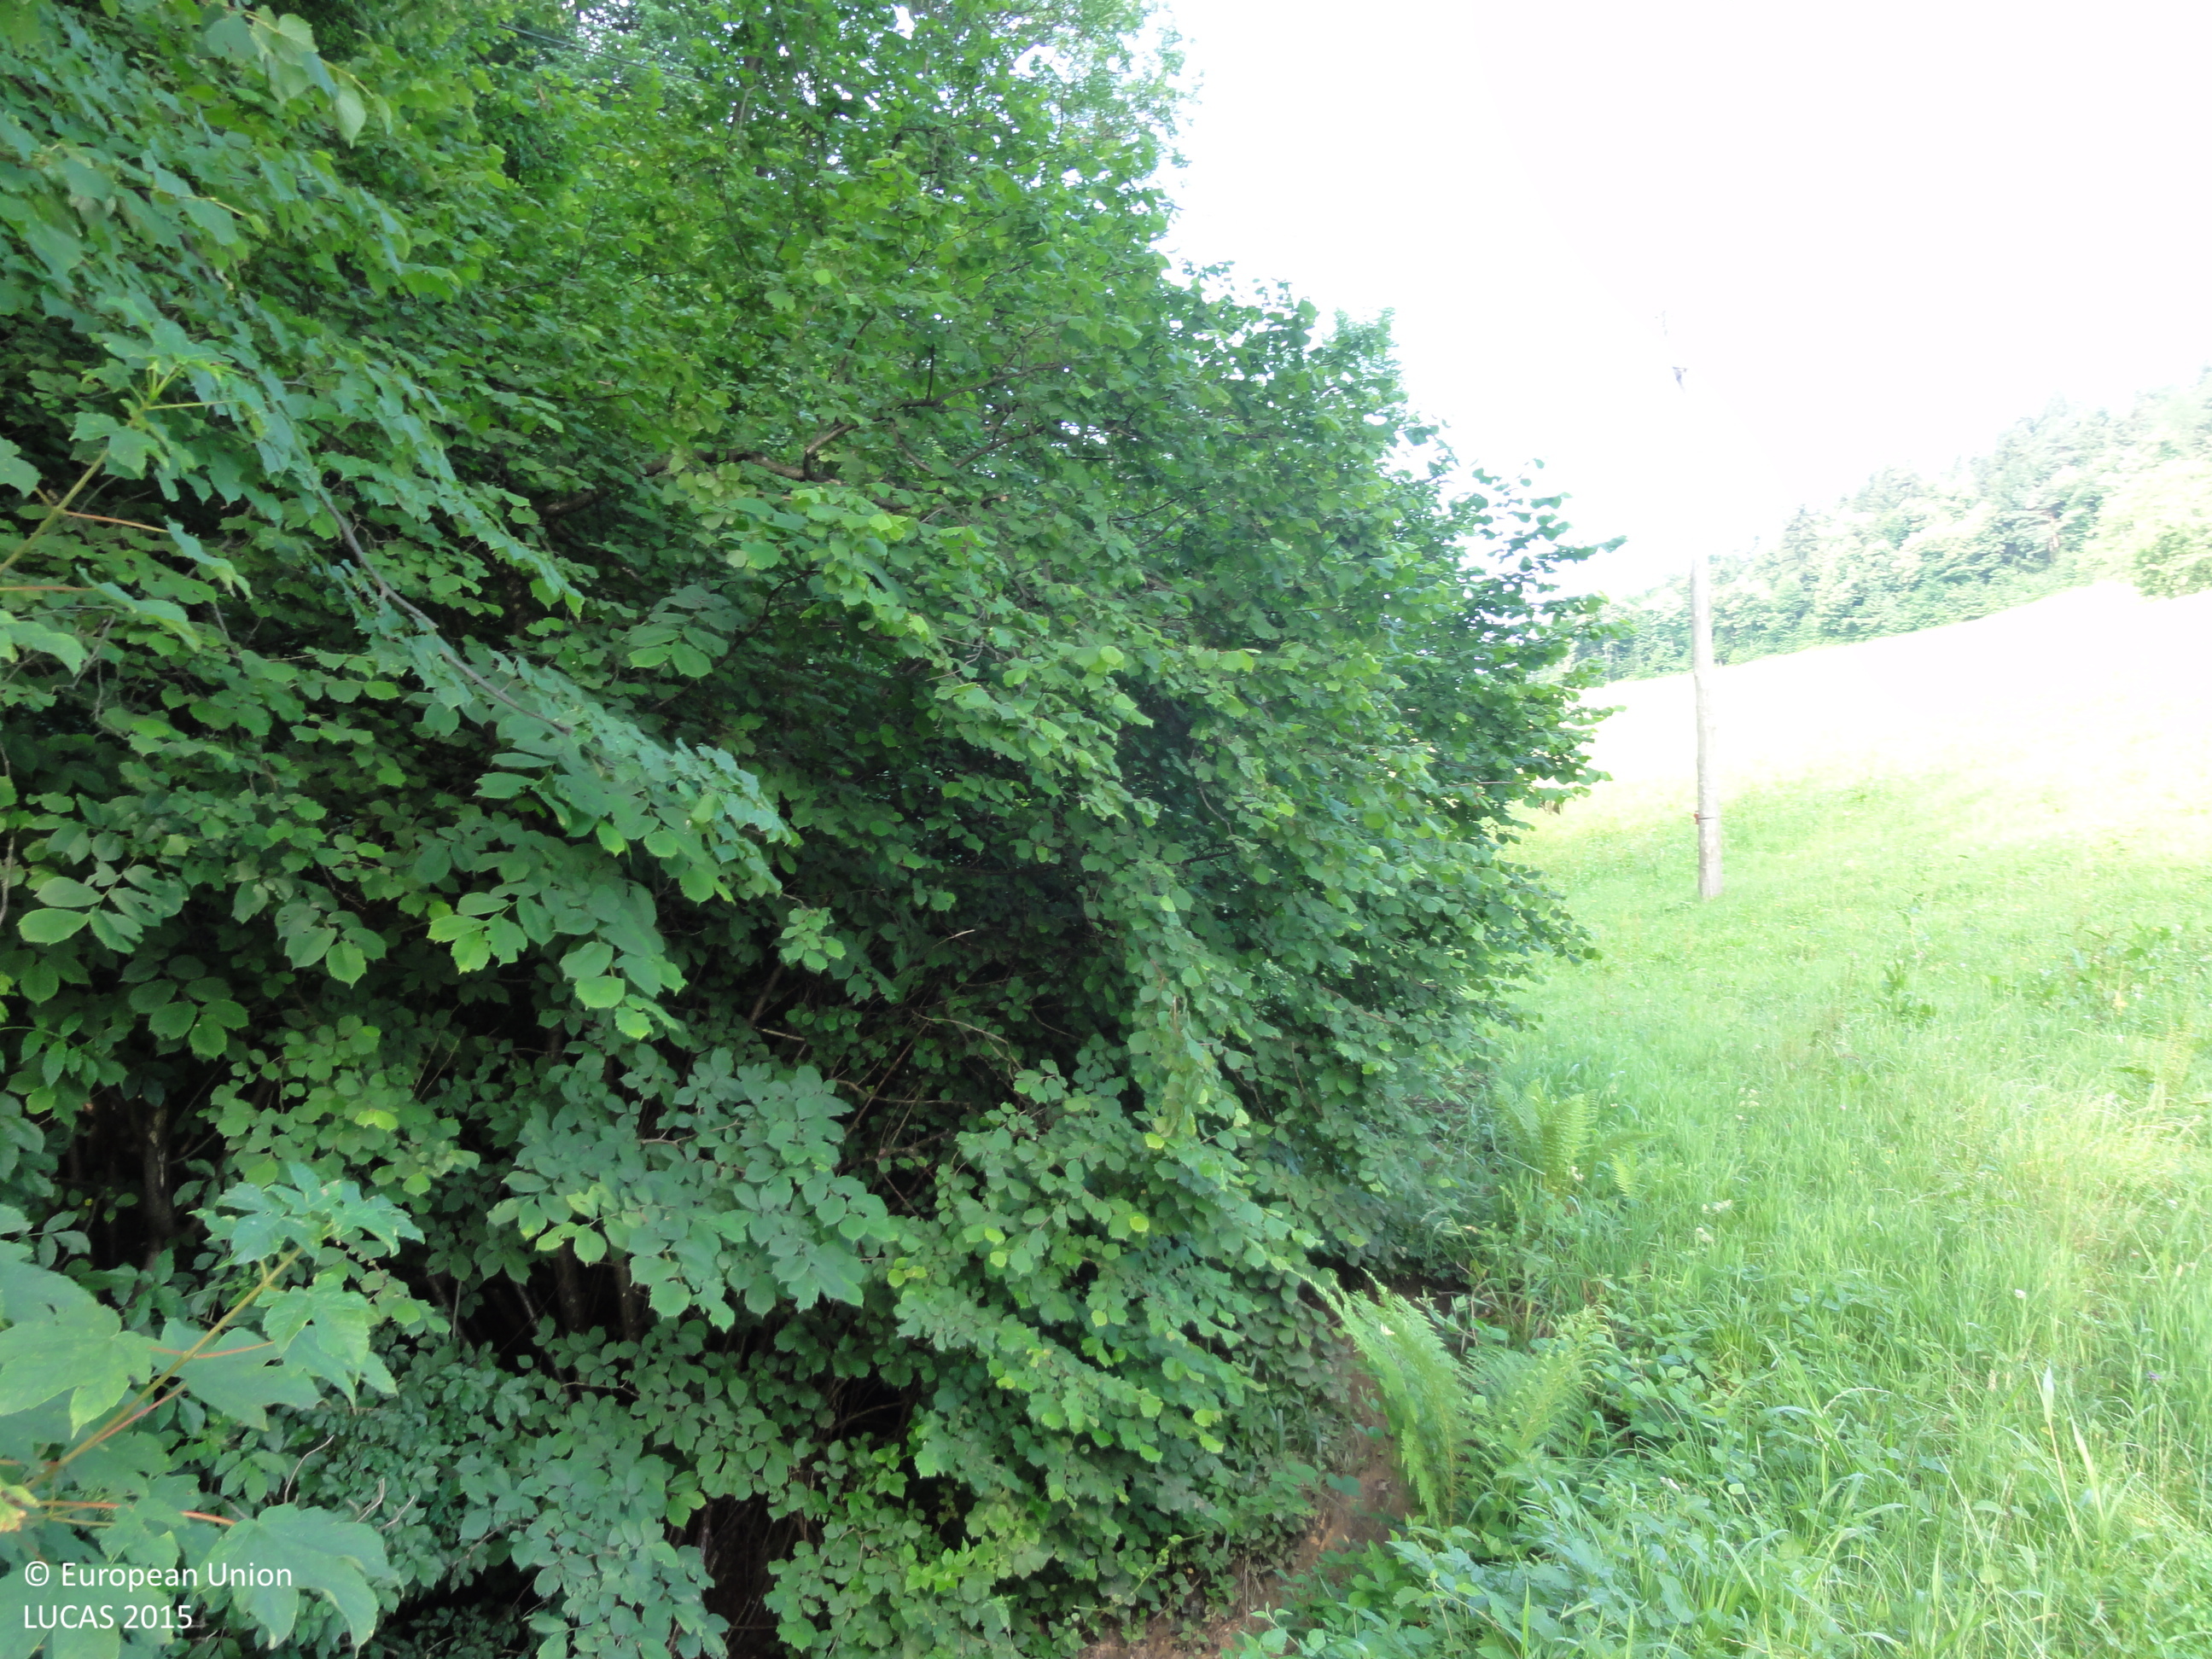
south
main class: Shrubland
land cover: Shrubland with sparse tree cover
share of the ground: > 75 %
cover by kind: shrubs 95 %, broadleaved forest trees 5 %
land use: Forestry
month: July
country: SI
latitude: 46.6223
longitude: 15.5494
